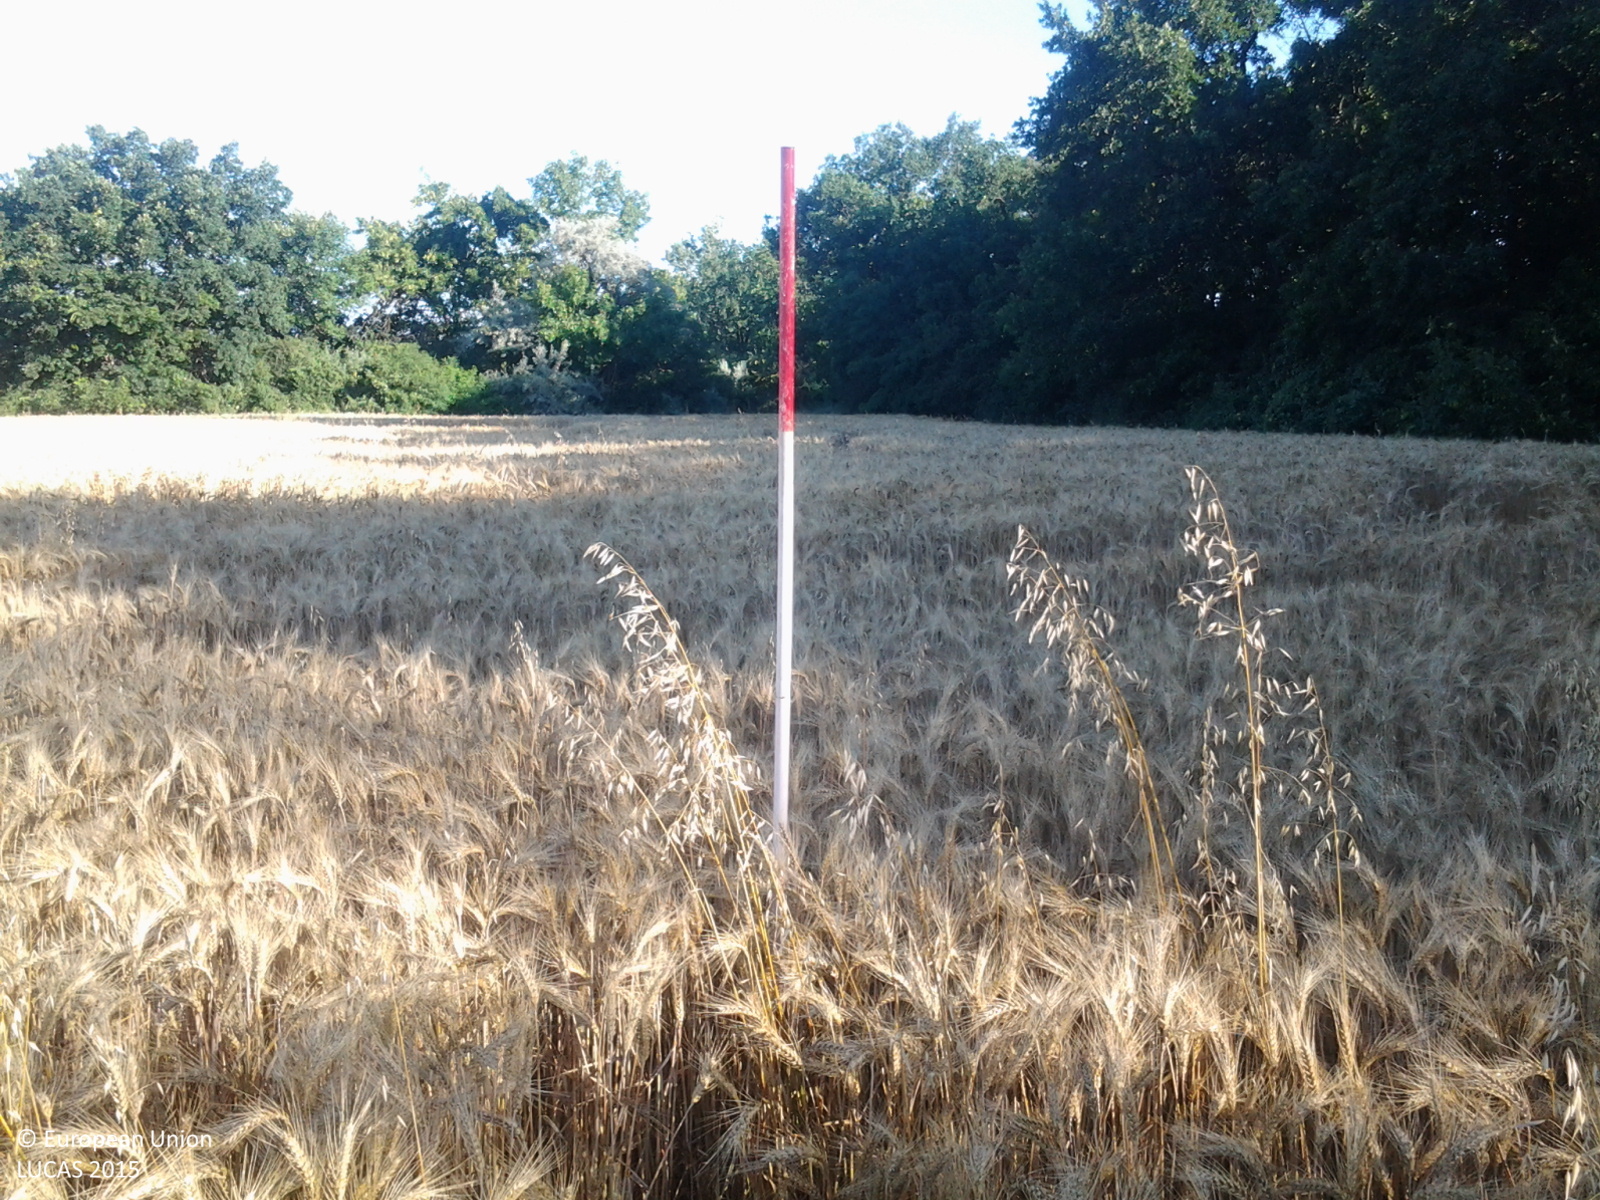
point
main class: Cropland
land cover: Common wheat
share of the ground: > 75 %
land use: Agriculture (excluding fallow land and kitchen gardens)
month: July
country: HU
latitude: 47.0473
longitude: 20.5200
